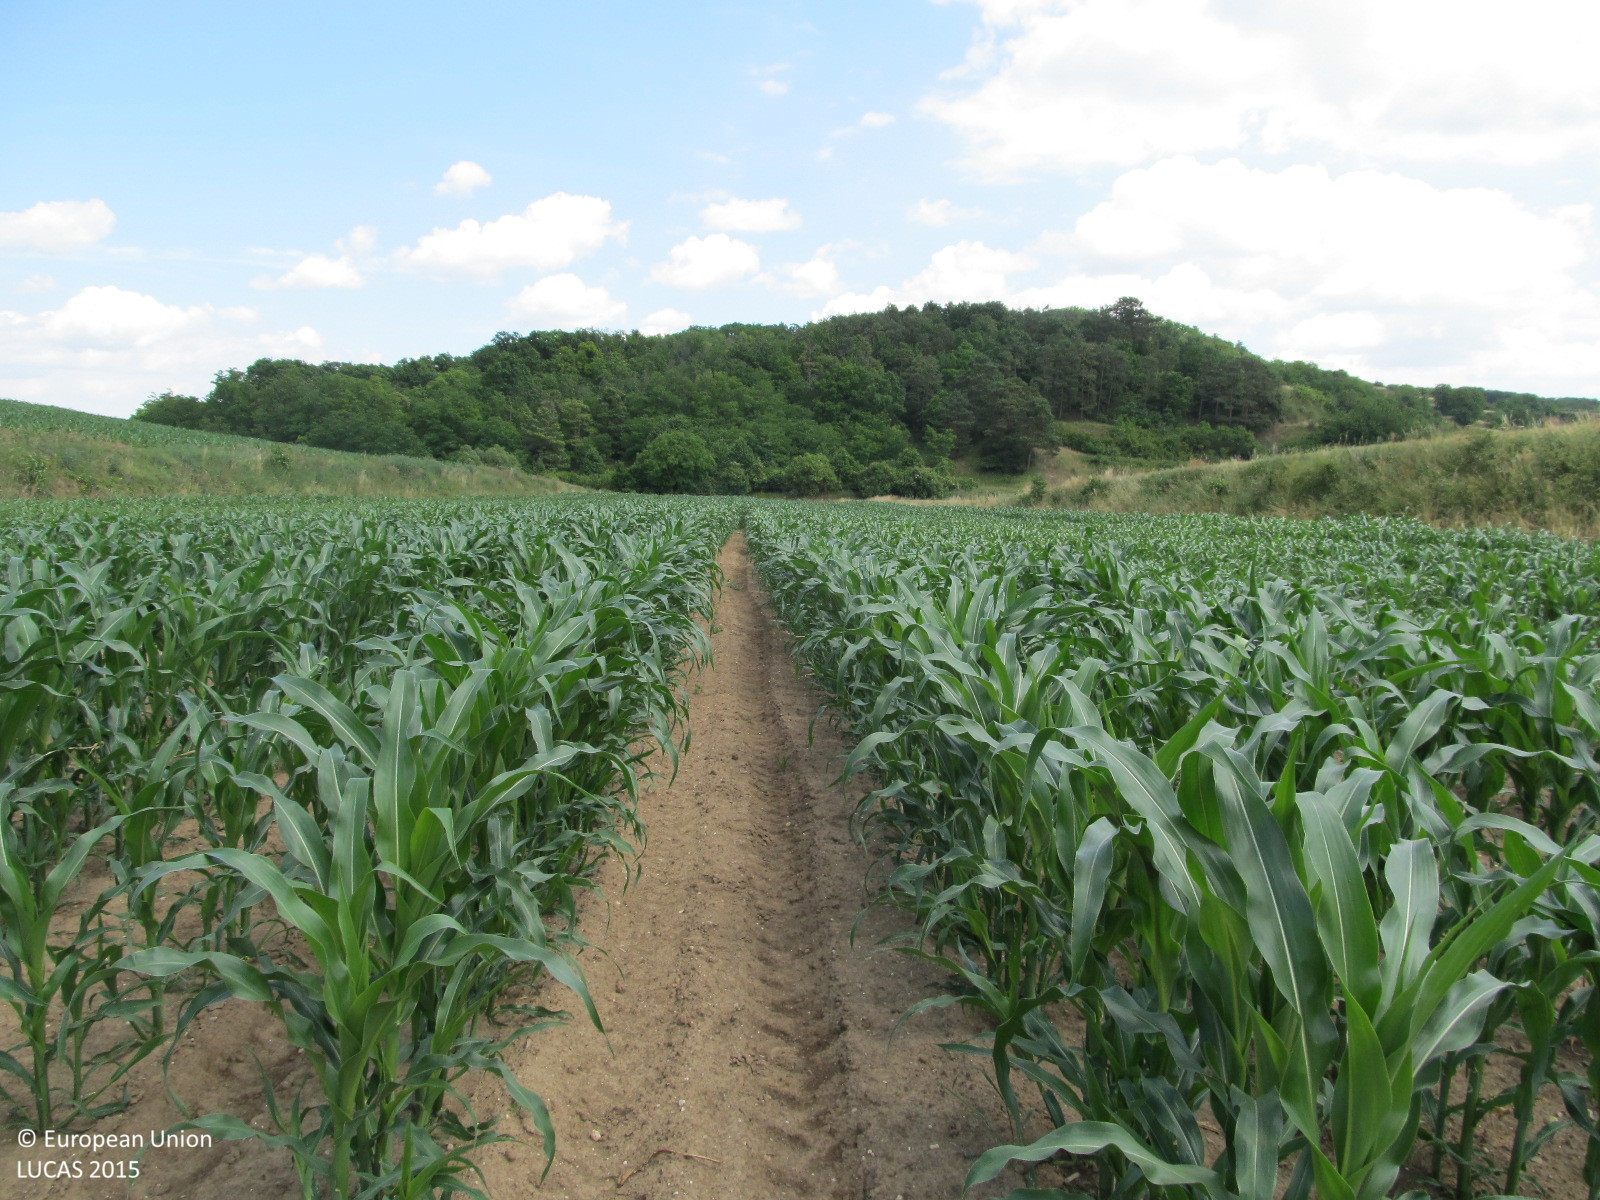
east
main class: Cropland
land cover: Maize
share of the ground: 50 - 75 %
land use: Agriculture (excluding fallow land and kitchen gardens)
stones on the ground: < 10 %
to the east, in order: Maize; Tracks; Grass margins; Ditches and canals; Grass margins; Tracks; Grass margins; Shrubland with sparse tree cover; Pine dominated mixed woodland; Tracks
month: June
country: AT
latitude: 48.5184
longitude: 15.8660
